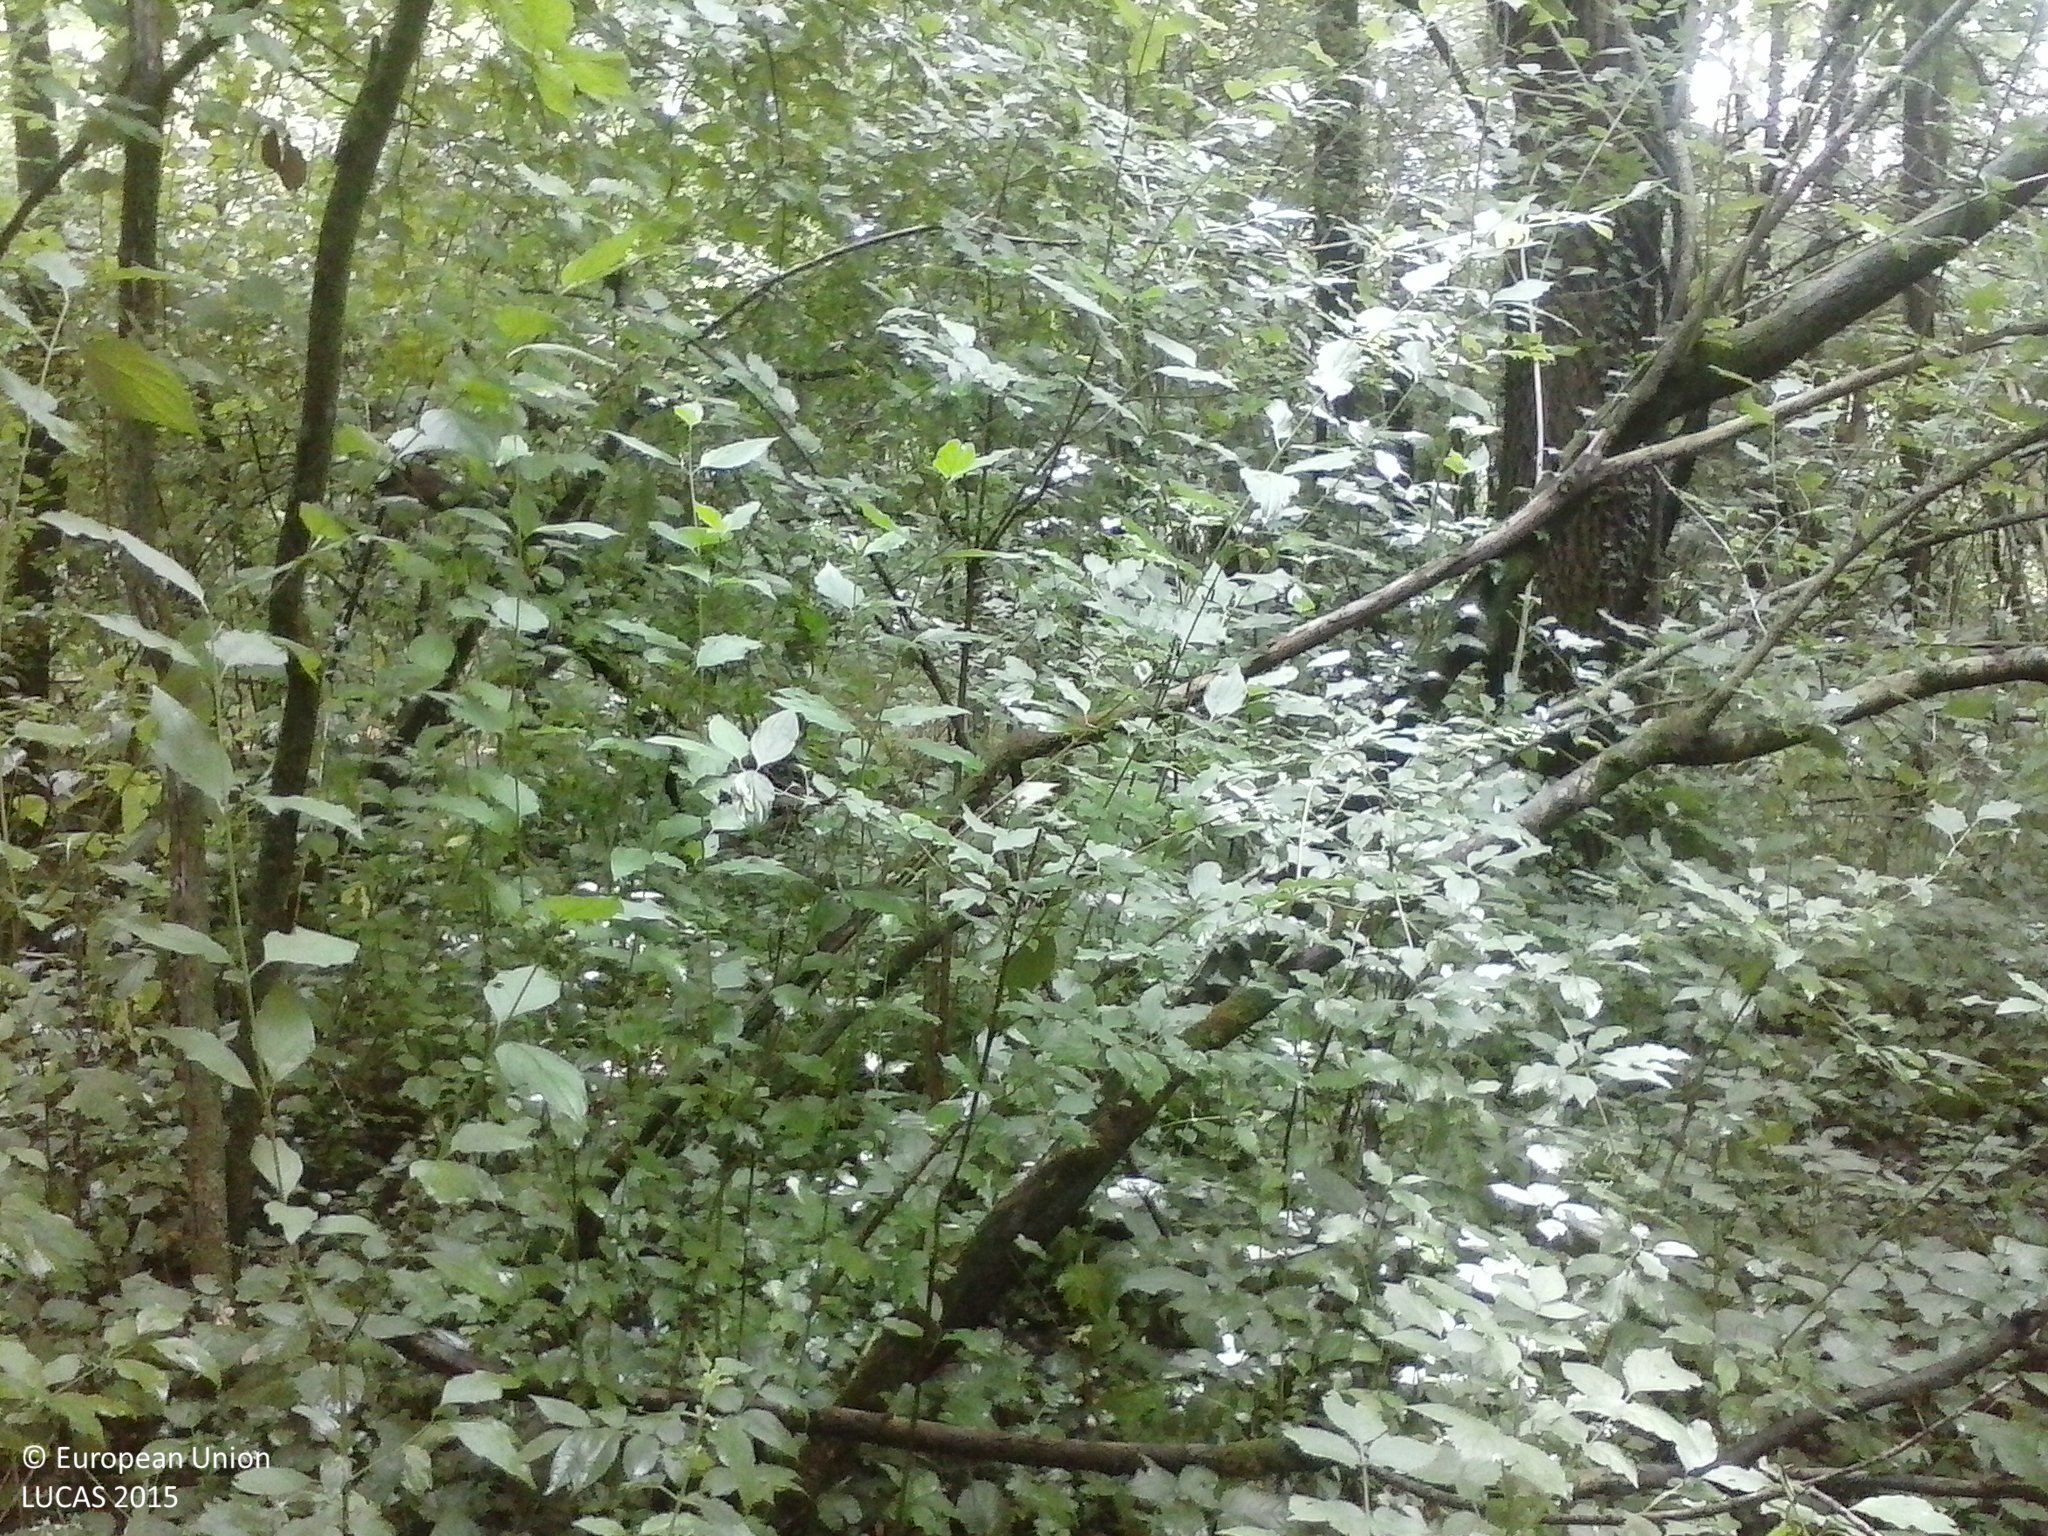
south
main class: Woodland
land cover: Broadleaved woodland
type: mesophytic deciduous forest
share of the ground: > 75 %
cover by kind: broadleaved forest trees 90 %, shrubs 5 %, herbaceous plants 5 %
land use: Forestry
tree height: > 5 m
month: July
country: HU
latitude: 46.0130
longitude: 17.2738
